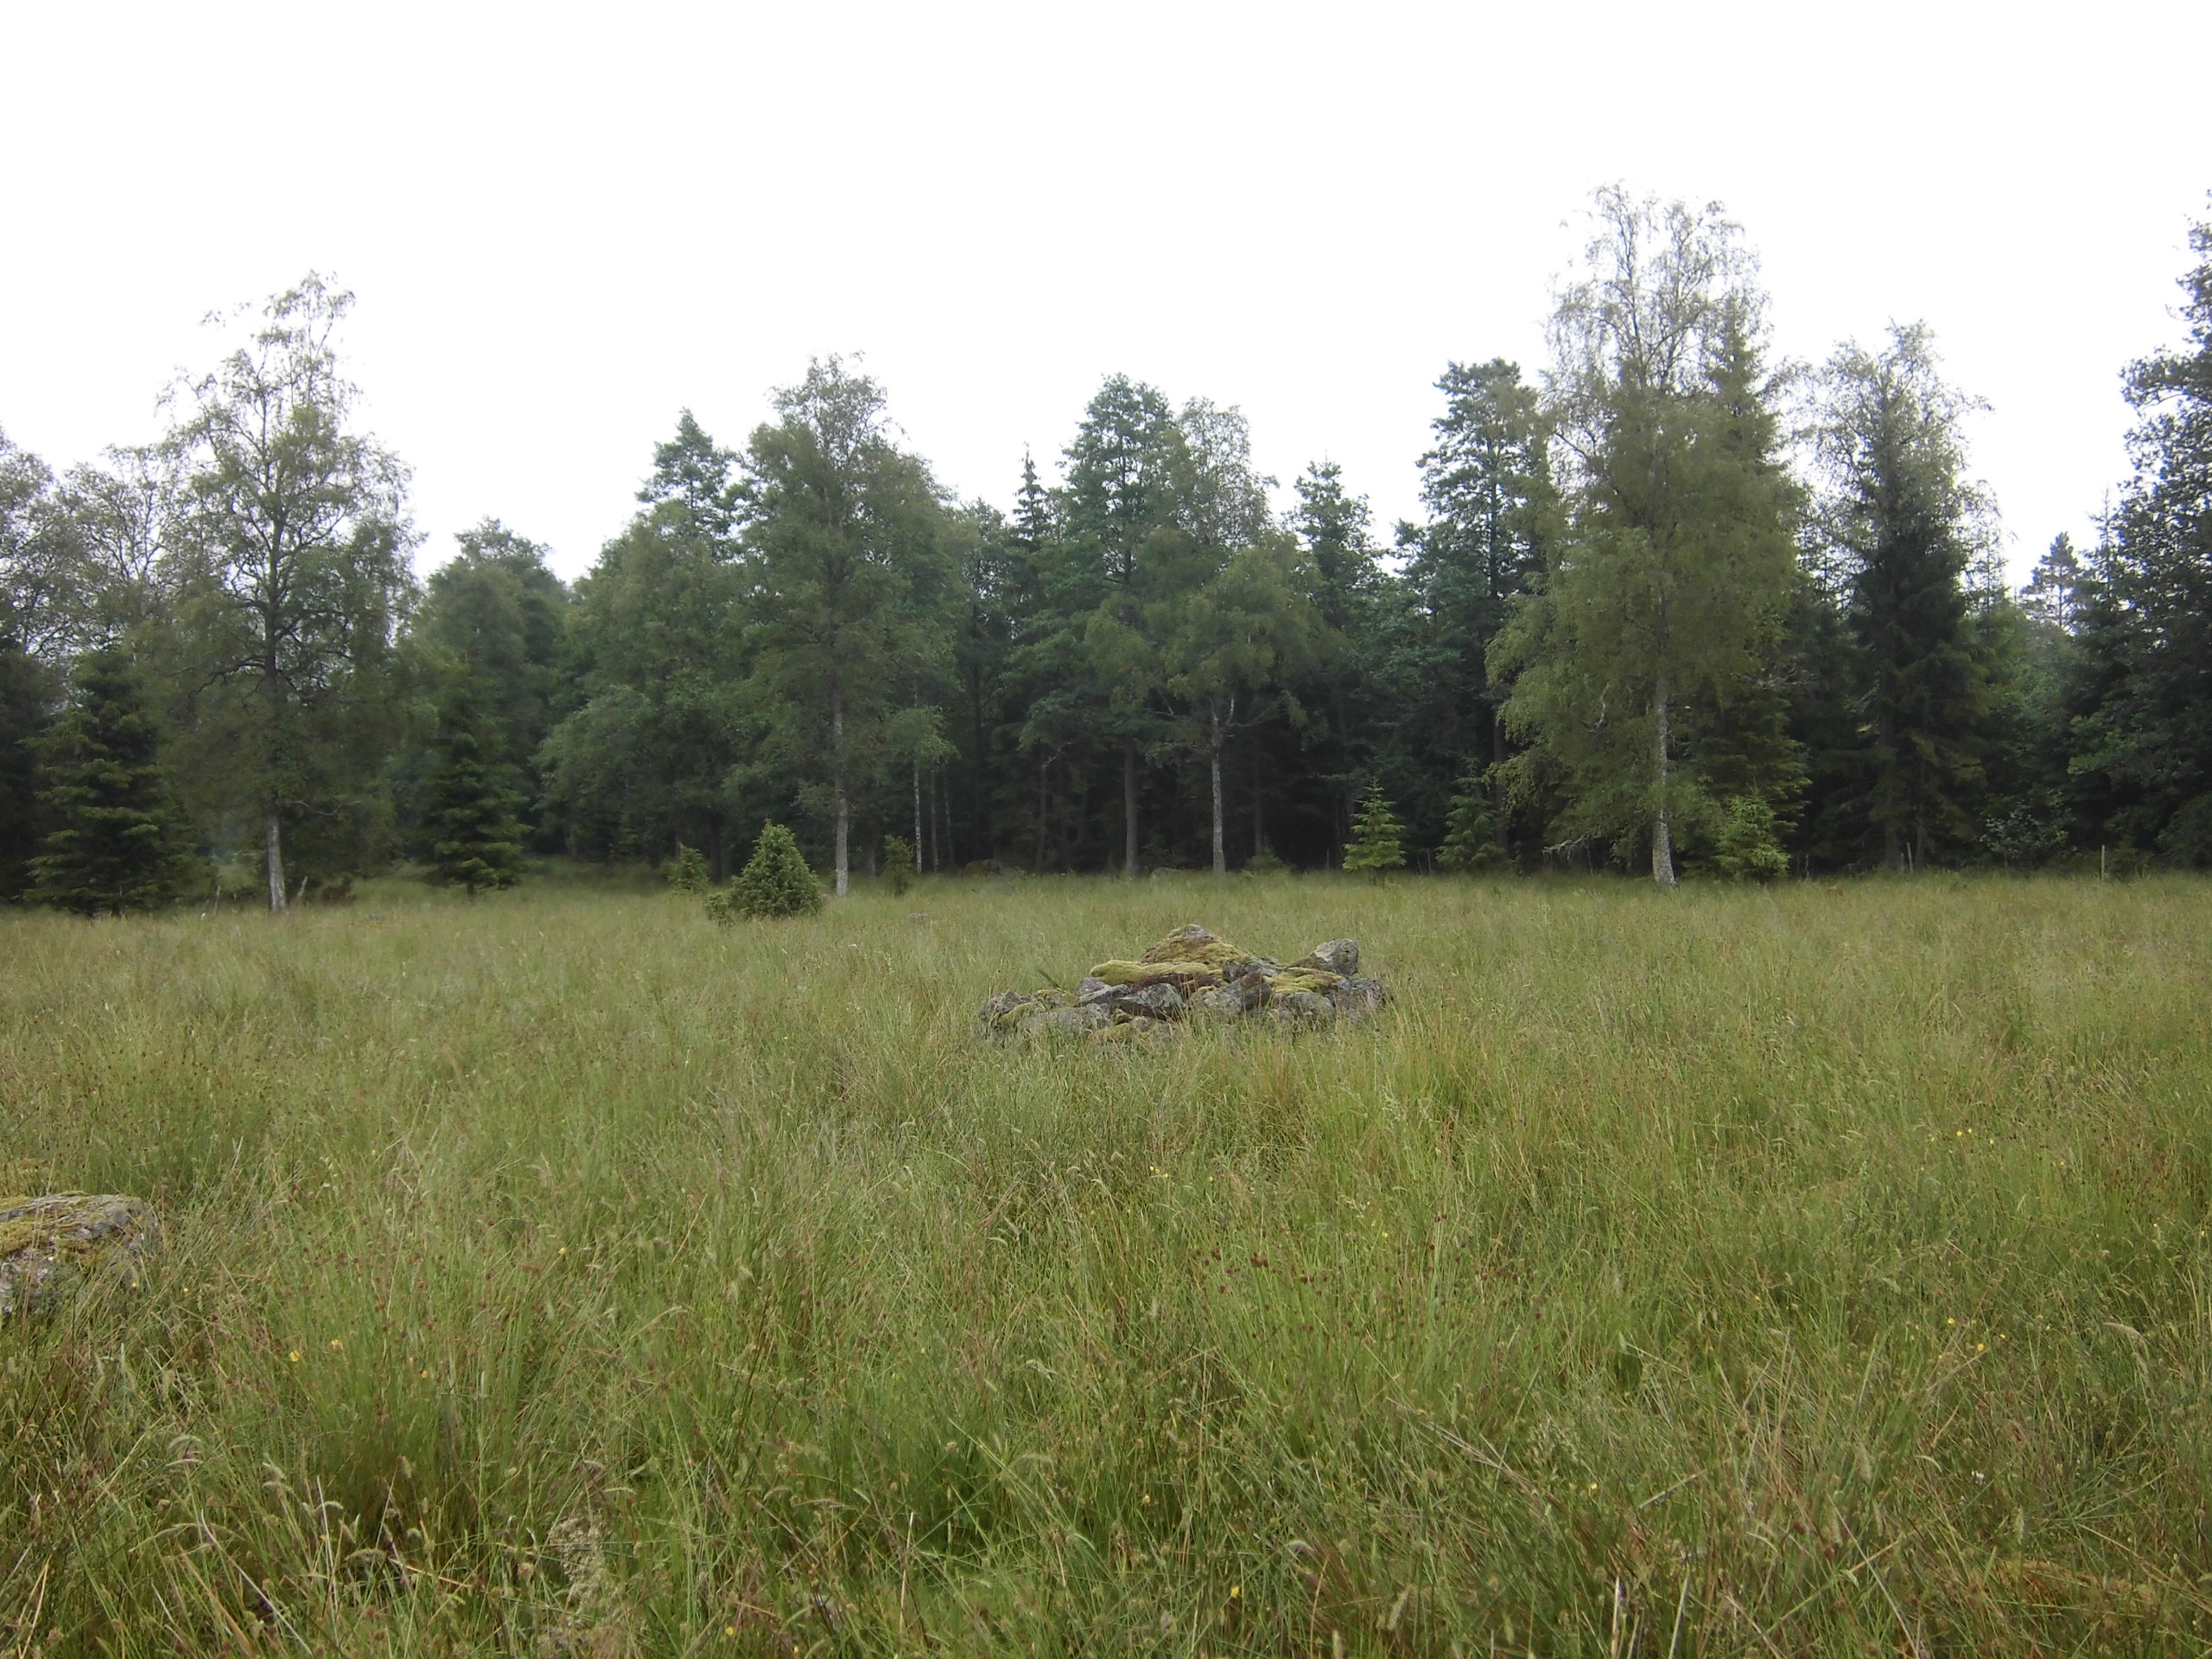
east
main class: Grassland
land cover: Grassland without tree/shrub cover
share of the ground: > 75 %
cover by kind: herbaceous plants 100 %
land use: Agriculture (excluding fallow land and kitchen gardens)
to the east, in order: Grassland without tree/shrub cover; Grassland with sparse tree/shrub cover; Broadleaved woodland; Fences; Spruce dominated mixed woodland; Spruce dominated coniferous woodland; Spruce dominated mixed woodland
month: July
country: SE
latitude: 57.3219
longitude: 14.8287
